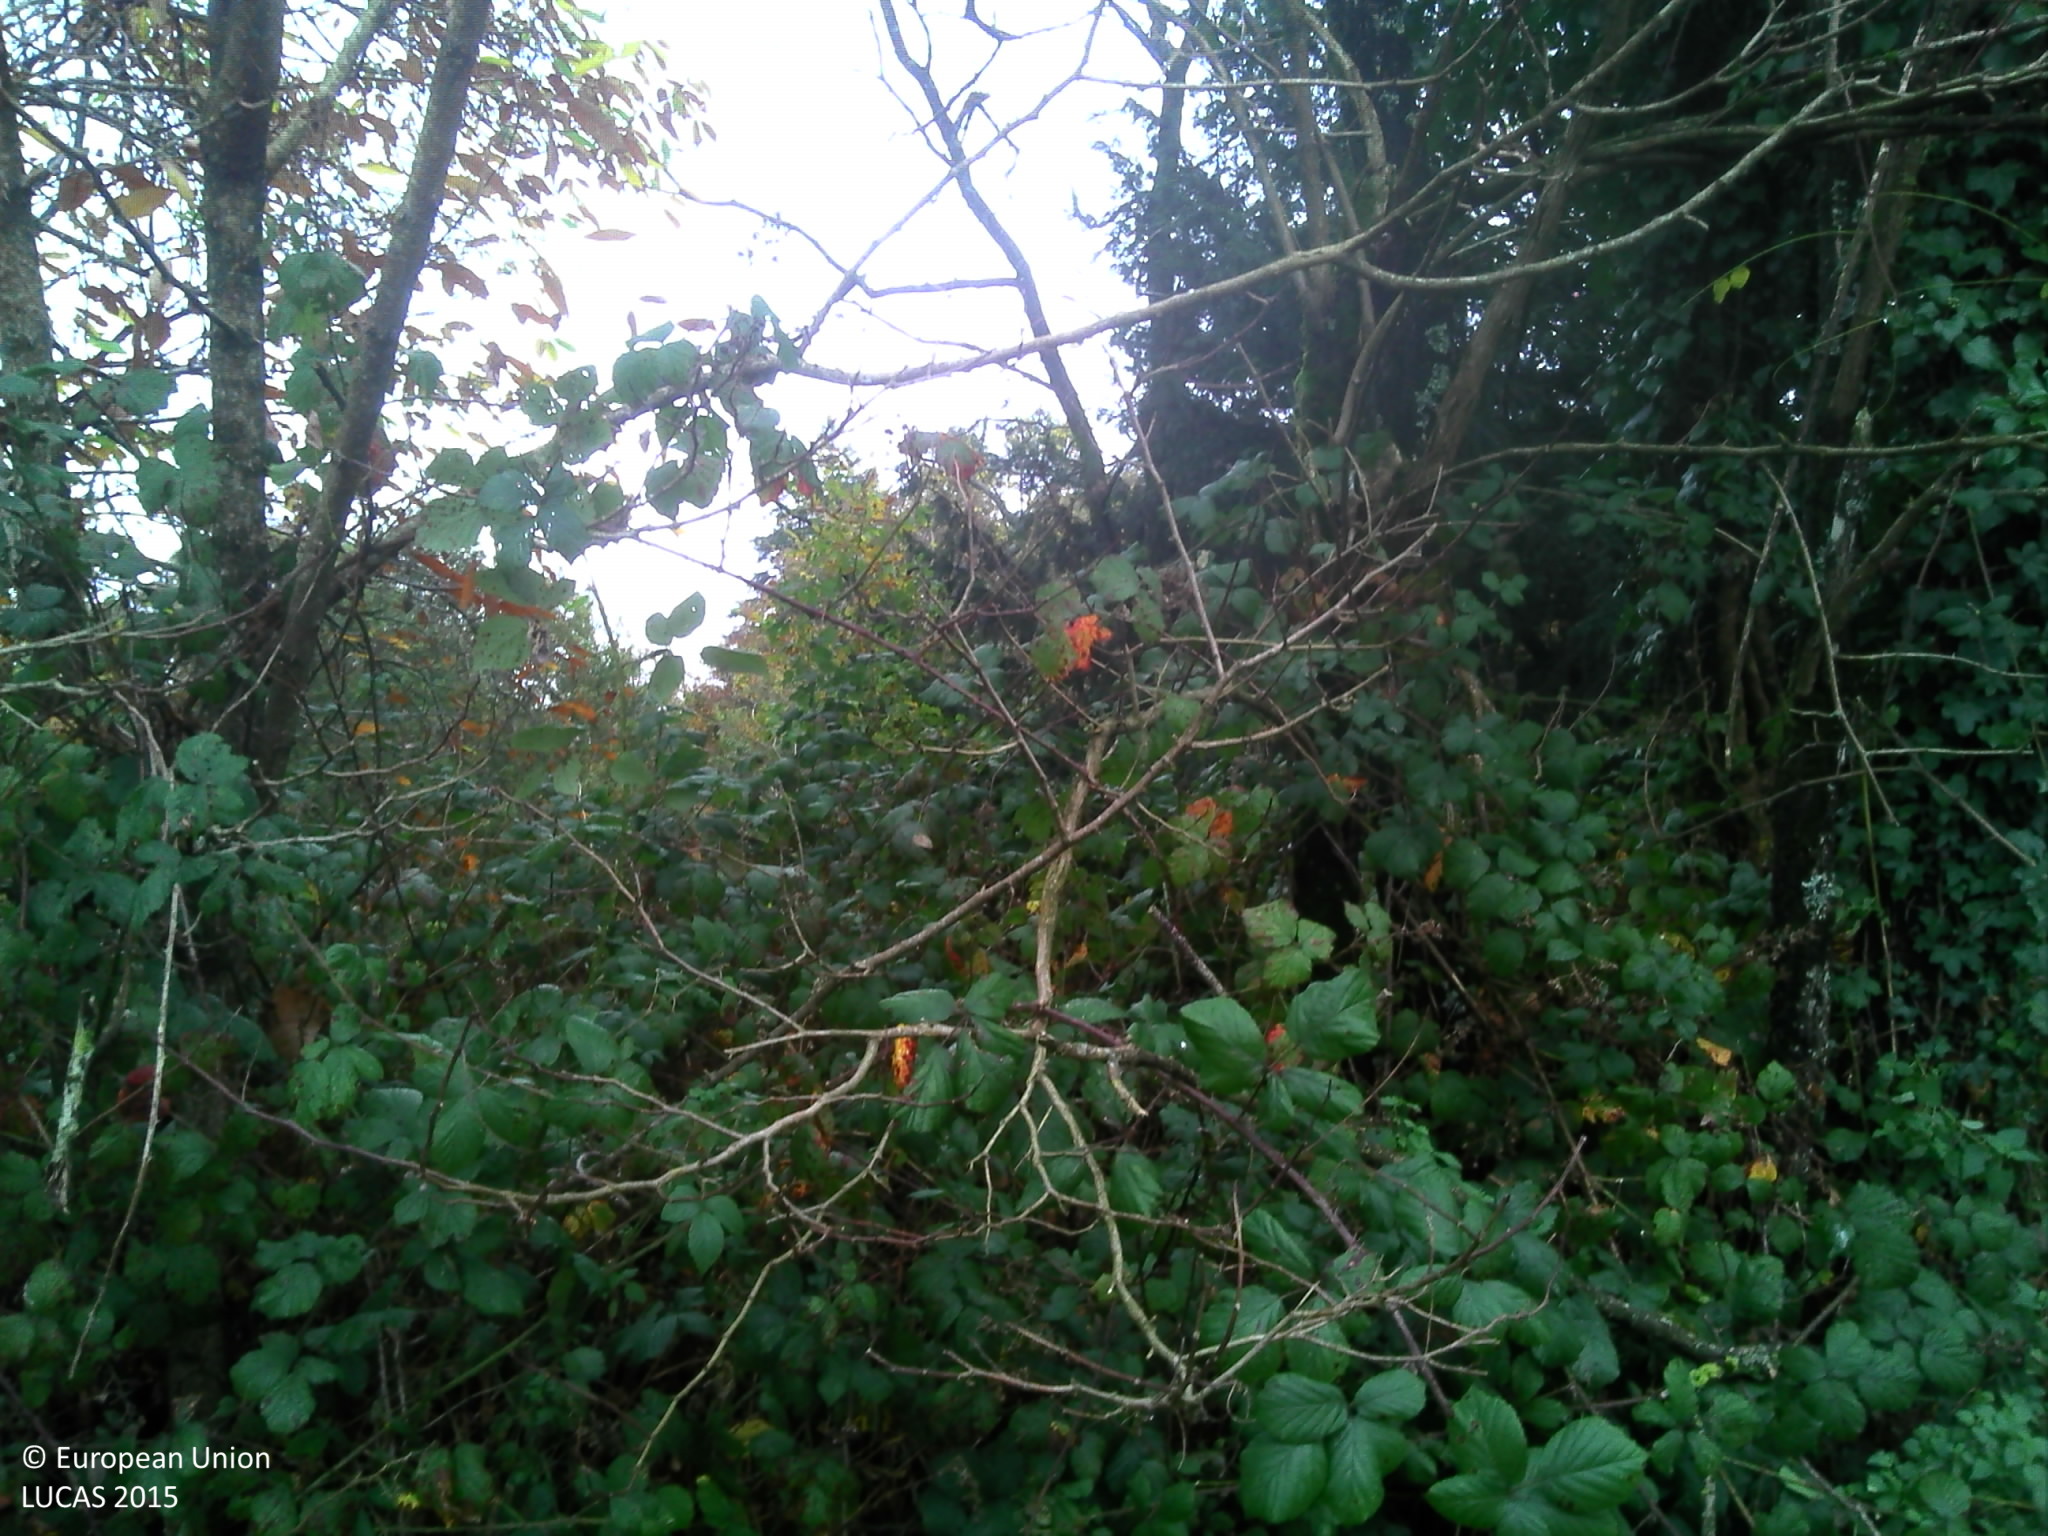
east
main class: Woodland
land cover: Broadleaved woodland
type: mesophytic deciduous forest
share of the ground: > 75 %
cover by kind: broadleaved forest trees 100 %
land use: Forestry
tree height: > 5 m
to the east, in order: Broadleaved woodland; Dry stone walls; Broadleaved woodland; Grassland with sparse tree/shrub cover; Dry stone walls; Spruce dominated mixed woodland; Dry stone walls; Broadleaved woodland; Artificial constructions in urban areas
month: November
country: FR
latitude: 47.9774
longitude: -3.1590
